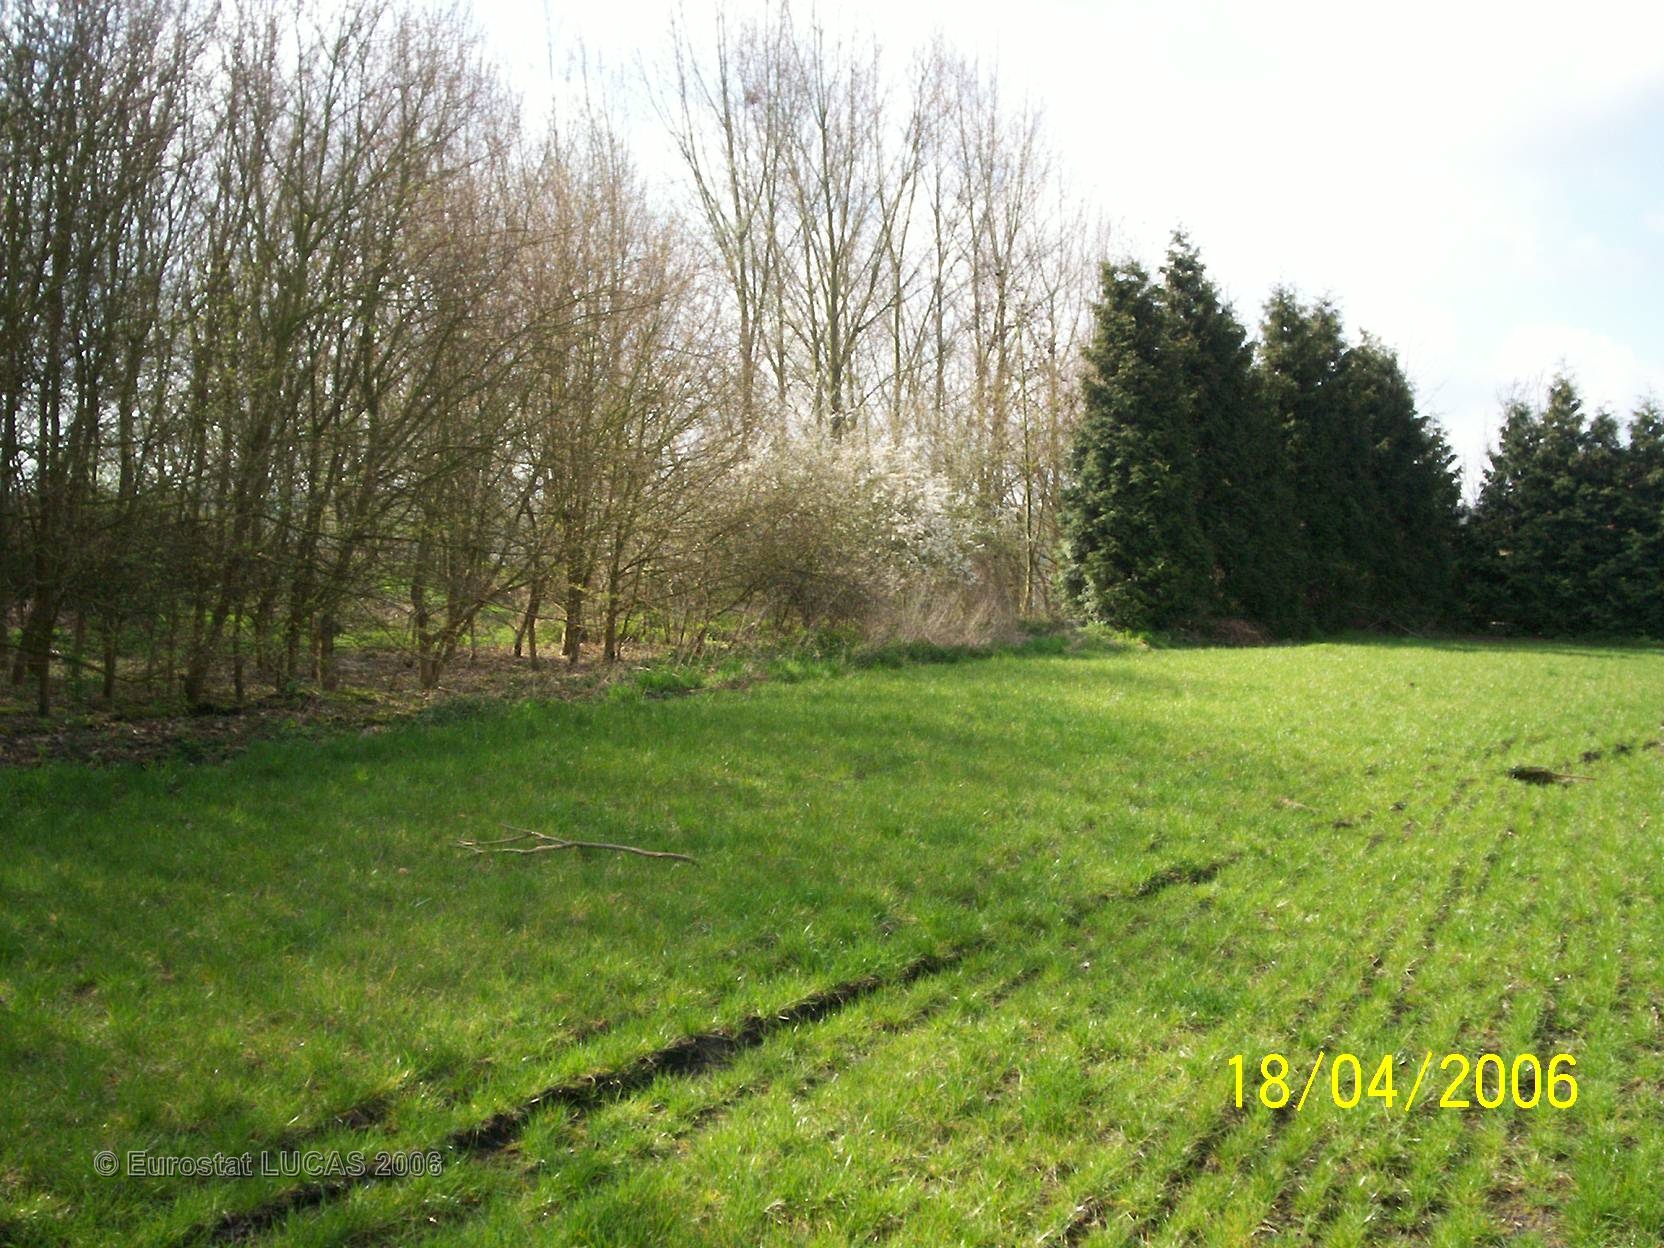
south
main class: Grassland
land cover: Grassland without tree/shrub cover
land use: Agriculture (excluding fallow land and kitchen gardens)
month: April
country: FR
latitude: 50.4507
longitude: 2.6223
